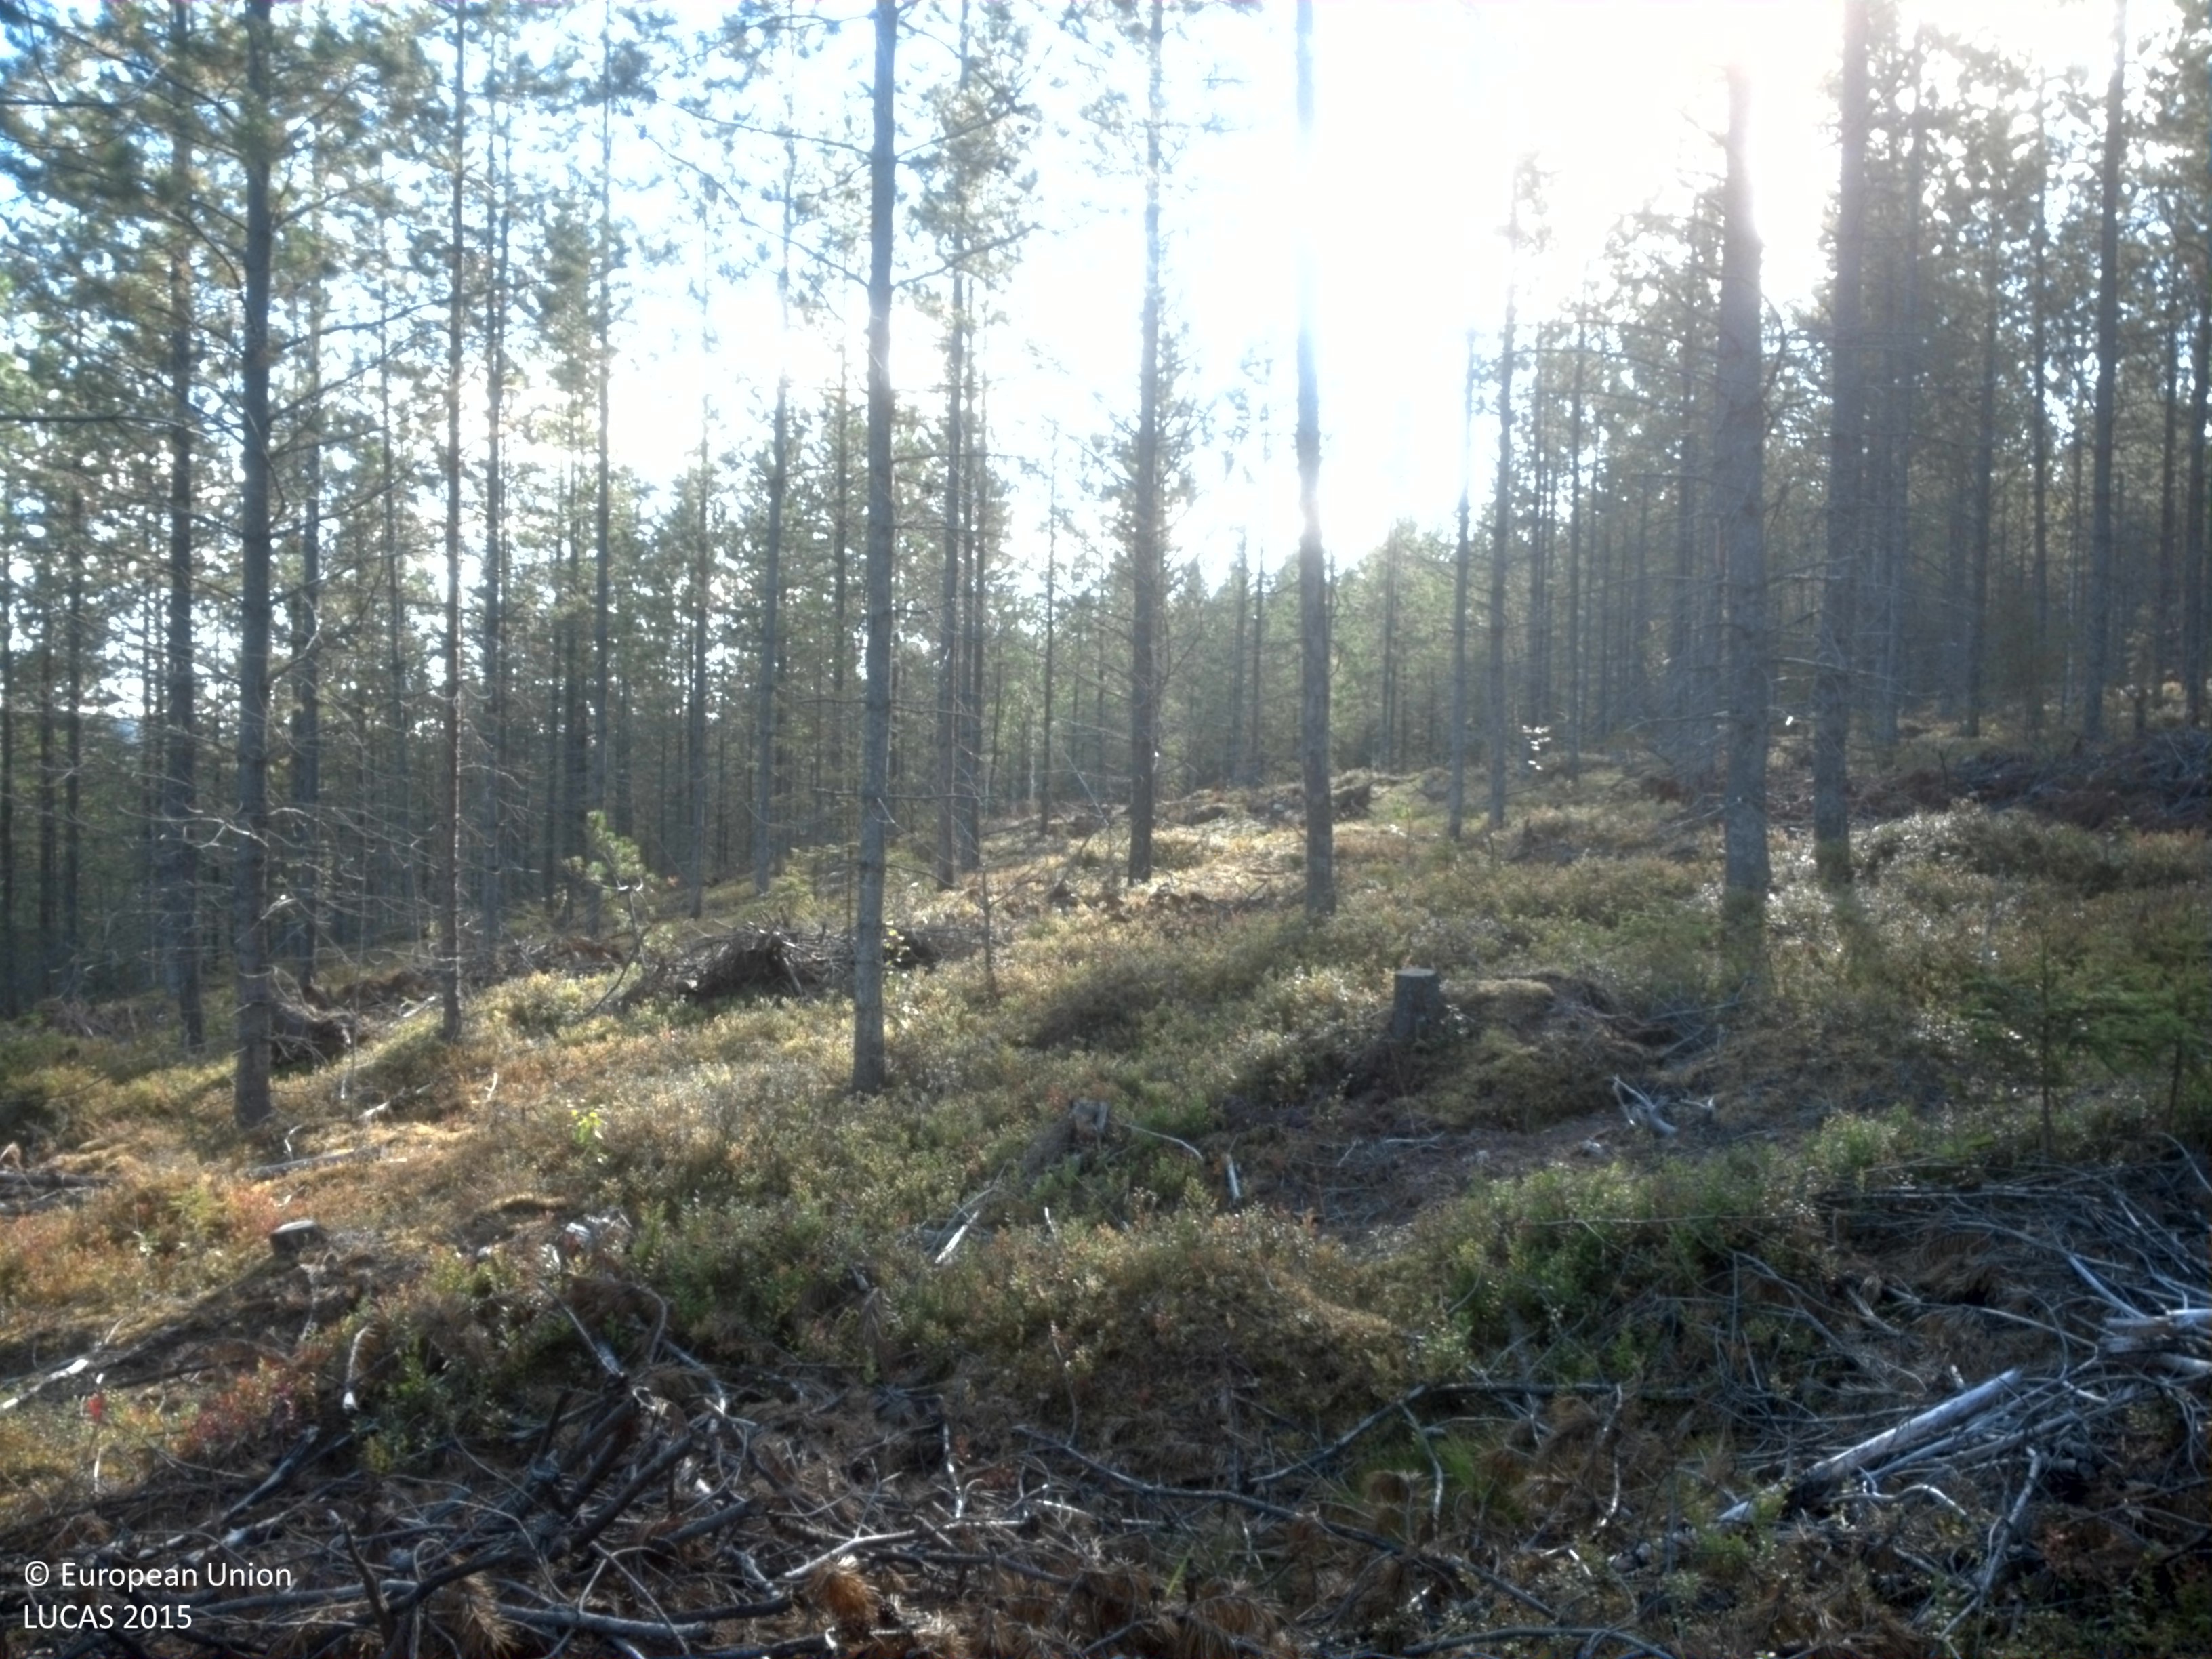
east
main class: Woodland
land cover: Pine dominated coniferous woodland
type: exotic forest
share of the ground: 50 - 75 %
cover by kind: coniferous forest trees 70 %, shrubs 20 %, lichens and mosses 10 %
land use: Forestry
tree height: > 5 m
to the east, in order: Pine dominated coniferous woodland; Tracks; Pine dominated coniferous woodland; Tracks; Pine dominated coniferous woodland; Tracks; Pine dominated coniferous woodland; Tracks; Pine dominated coniferous woodland; Pine dominated mixed woodland; Spruce dominated mixed woodland; Pine dominated mixed woodland; Pine dominated coniferous woodland
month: September
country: SE
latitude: 64.5560
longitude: 19.0858
